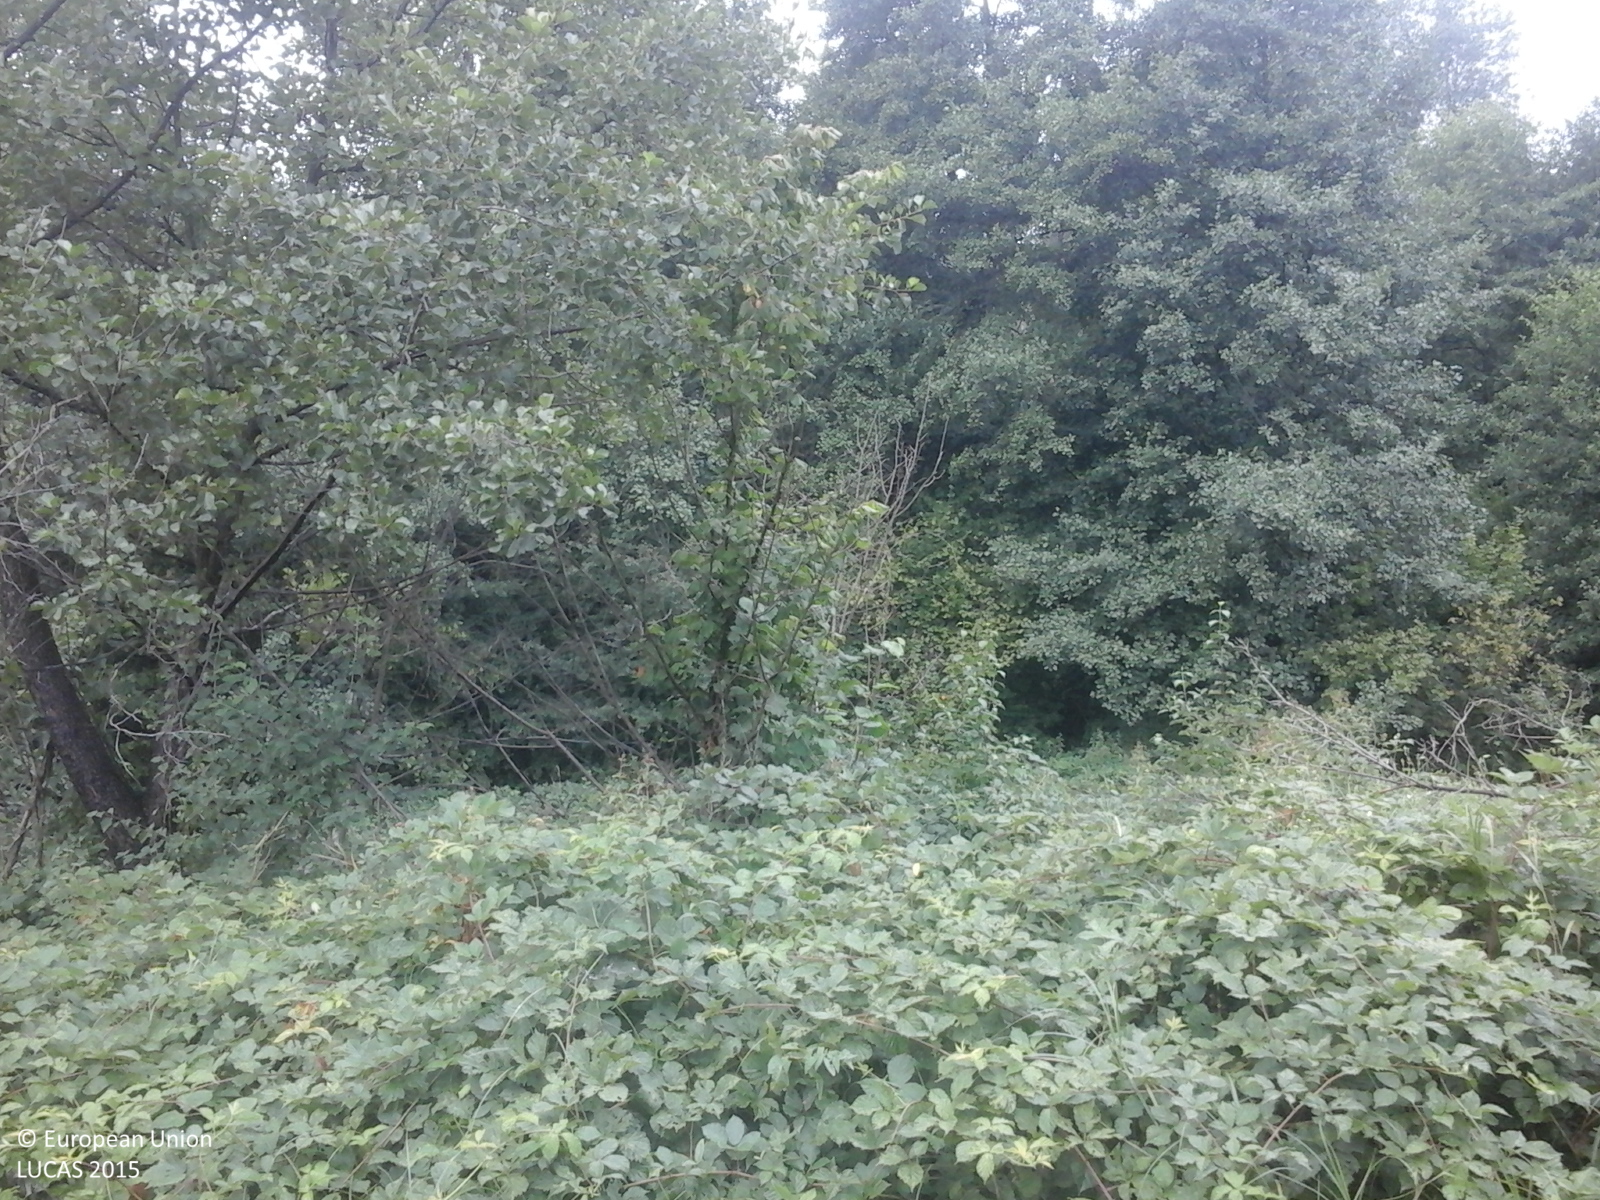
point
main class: Woodland
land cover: Broadleaved woodland
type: thermophilous deciduous forest
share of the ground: > 75 %
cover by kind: broadleaved forest trees 100 %
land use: Forestry
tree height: > 5 m
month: August
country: RO
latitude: 44.9999
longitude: 22.1522
